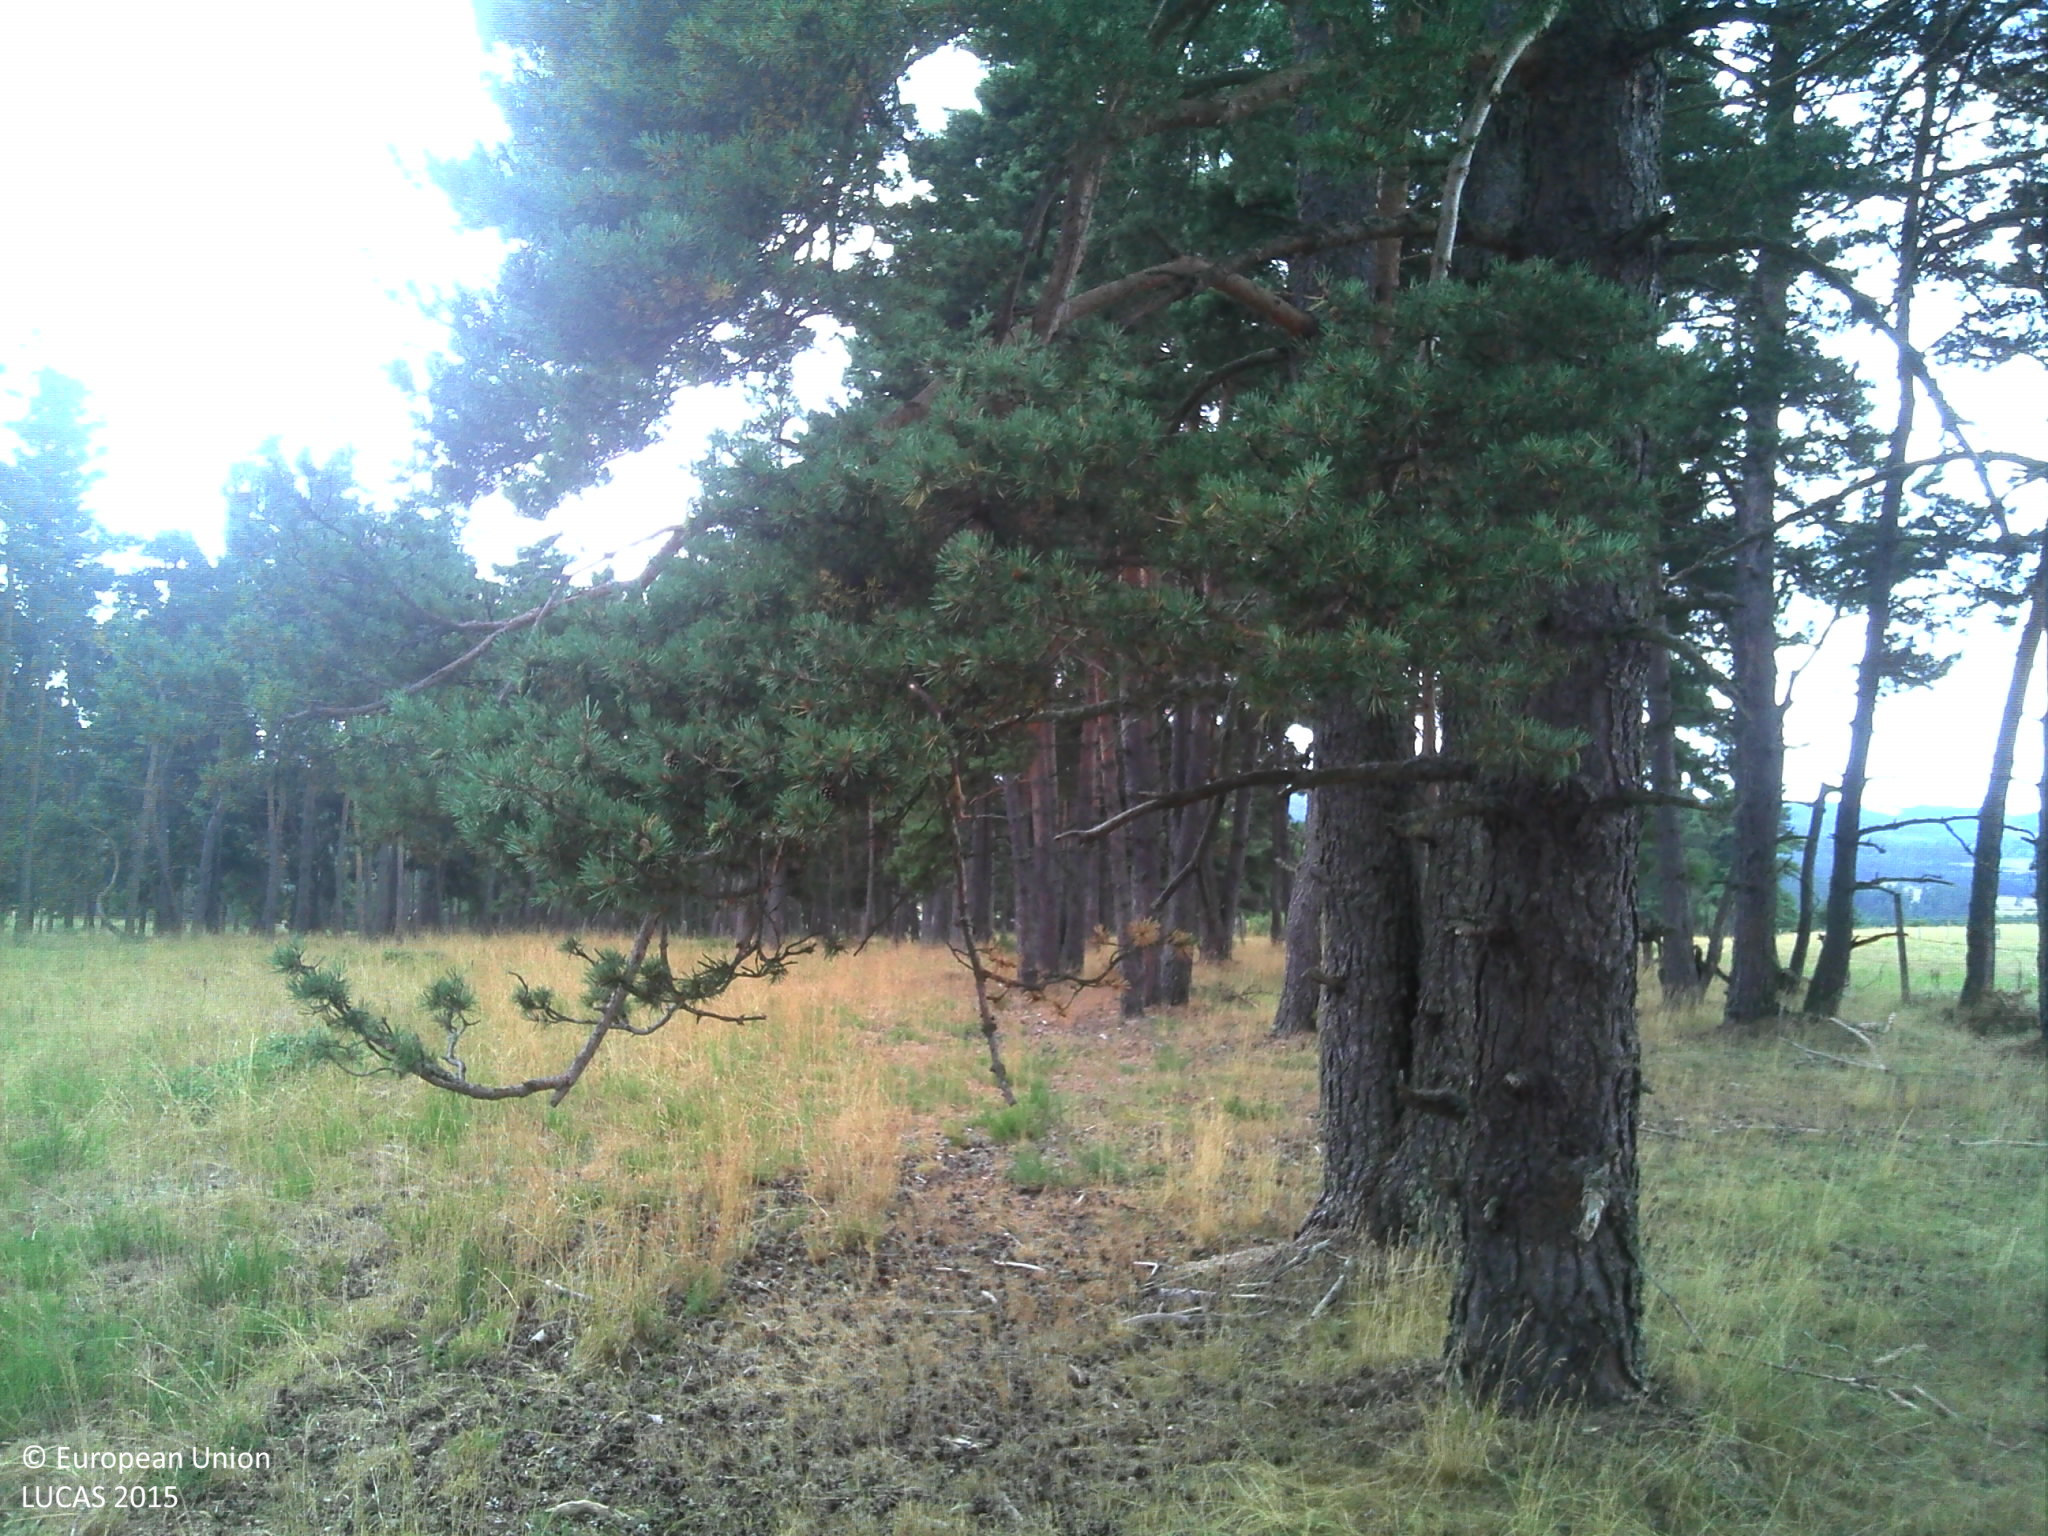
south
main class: Woodland
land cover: Pine dominated coniferous woodland
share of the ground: > 75 %
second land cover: Grassland without tree/shrub cover
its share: > 75 %
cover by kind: coniferous forest trees 95 %, broadleaved forest trees 5 %
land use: Forestry
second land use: Agriculture (excluding fallow land and kitchen gardens)
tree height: > 5 m
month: July
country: FR
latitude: 44.6933
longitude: 3.2782
